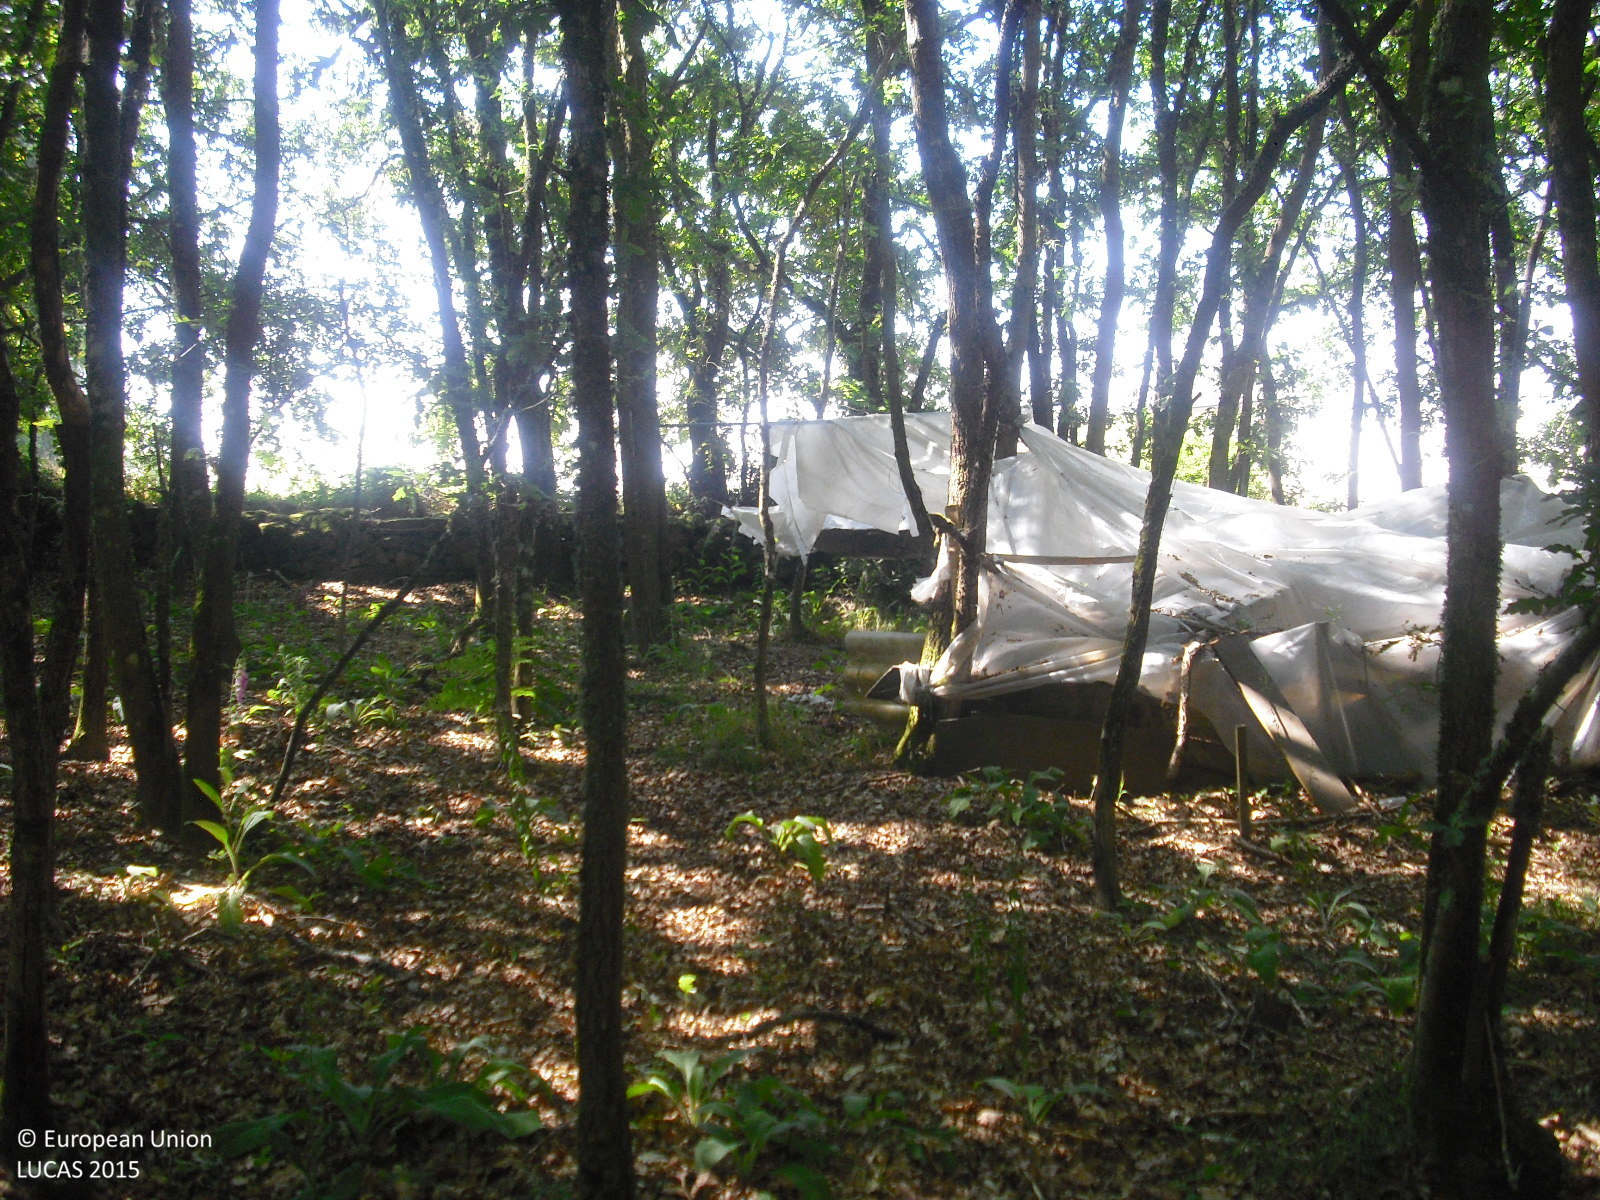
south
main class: Woodland
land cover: Broadleaved woodland
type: thermophilous deciduous forest
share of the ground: > 75 %
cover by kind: broadleaved forest trees 100 %
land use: Forestry
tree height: > 5 m
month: June
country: ES
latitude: 42.6043
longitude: -7.7387
